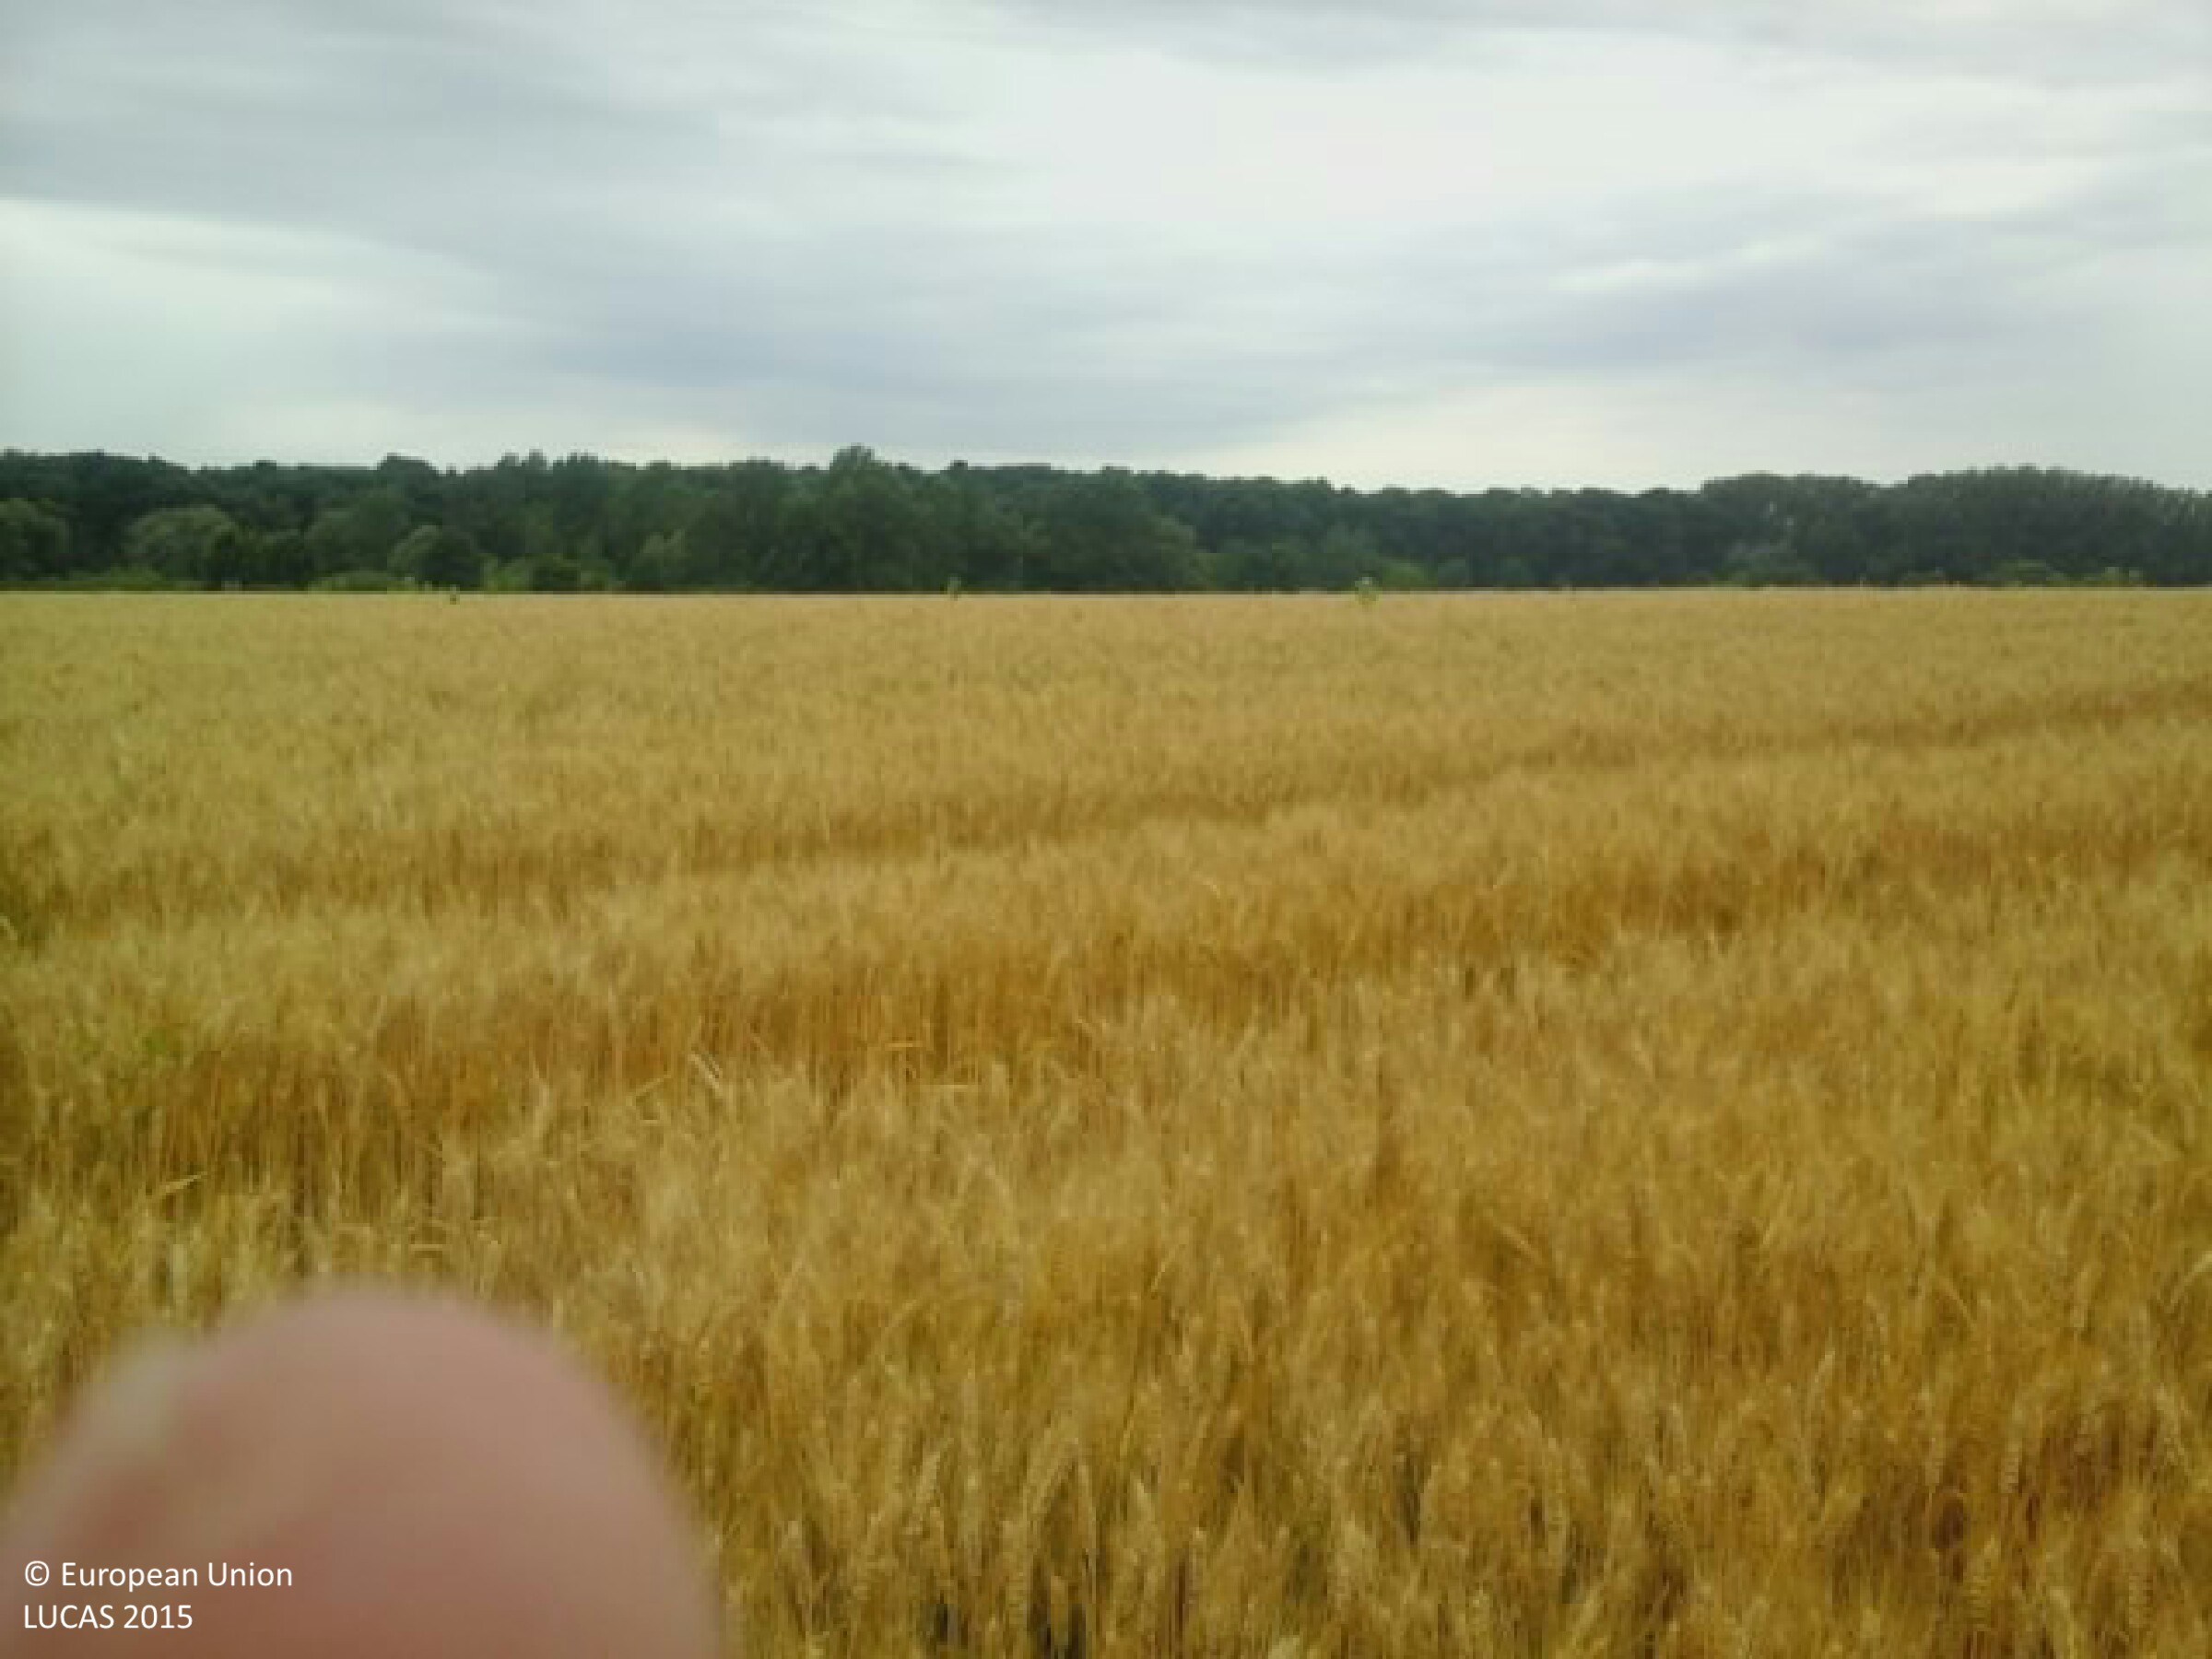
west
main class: Cropland
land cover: Common wheat
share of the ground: > 75 %
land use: Agriculture (excluding fallow land and kitchen gardens)
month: June
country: HU
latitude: 46.3409
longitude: 18.9122
